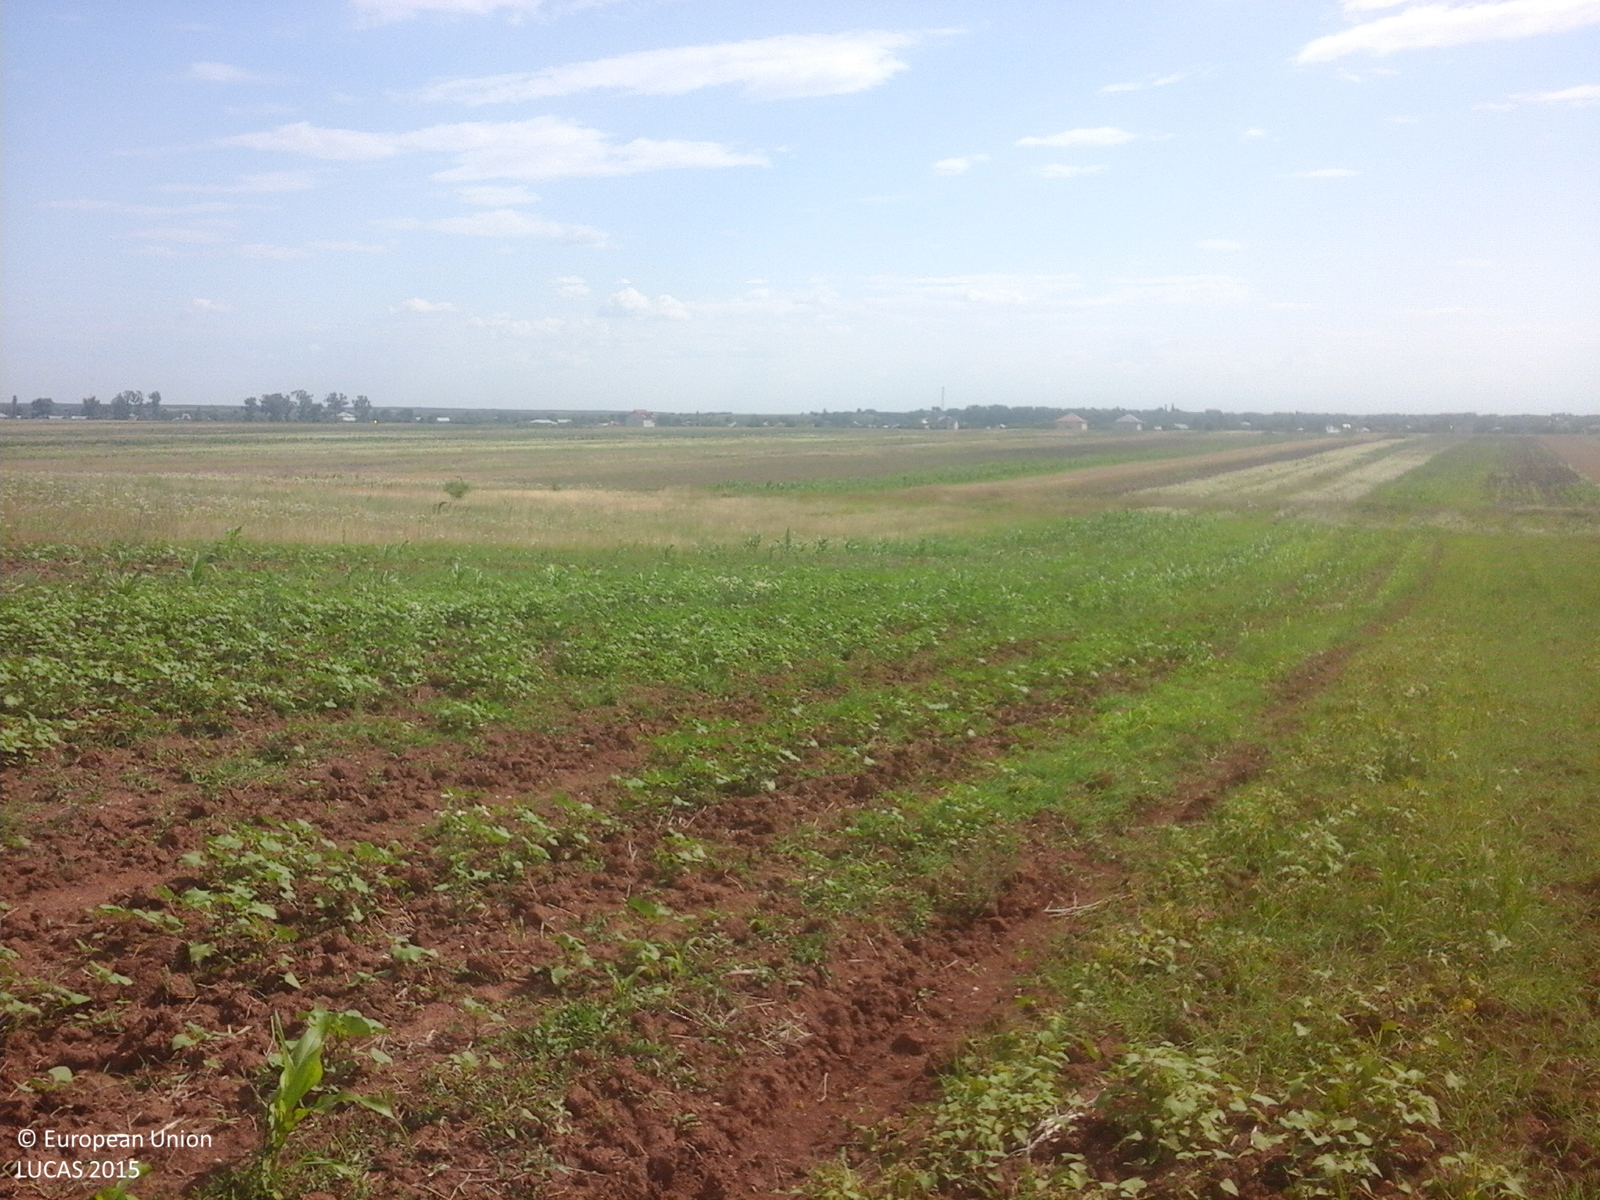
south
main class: Cropland
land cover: Other cereals
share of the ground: < 10 %
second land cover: Spontaneously vegetated surfaces
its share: < 10 %
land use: Agriculture (excluding fallow land and kitchen gardens)
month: July
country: RO
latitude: 44.4490
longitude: 25.4586
